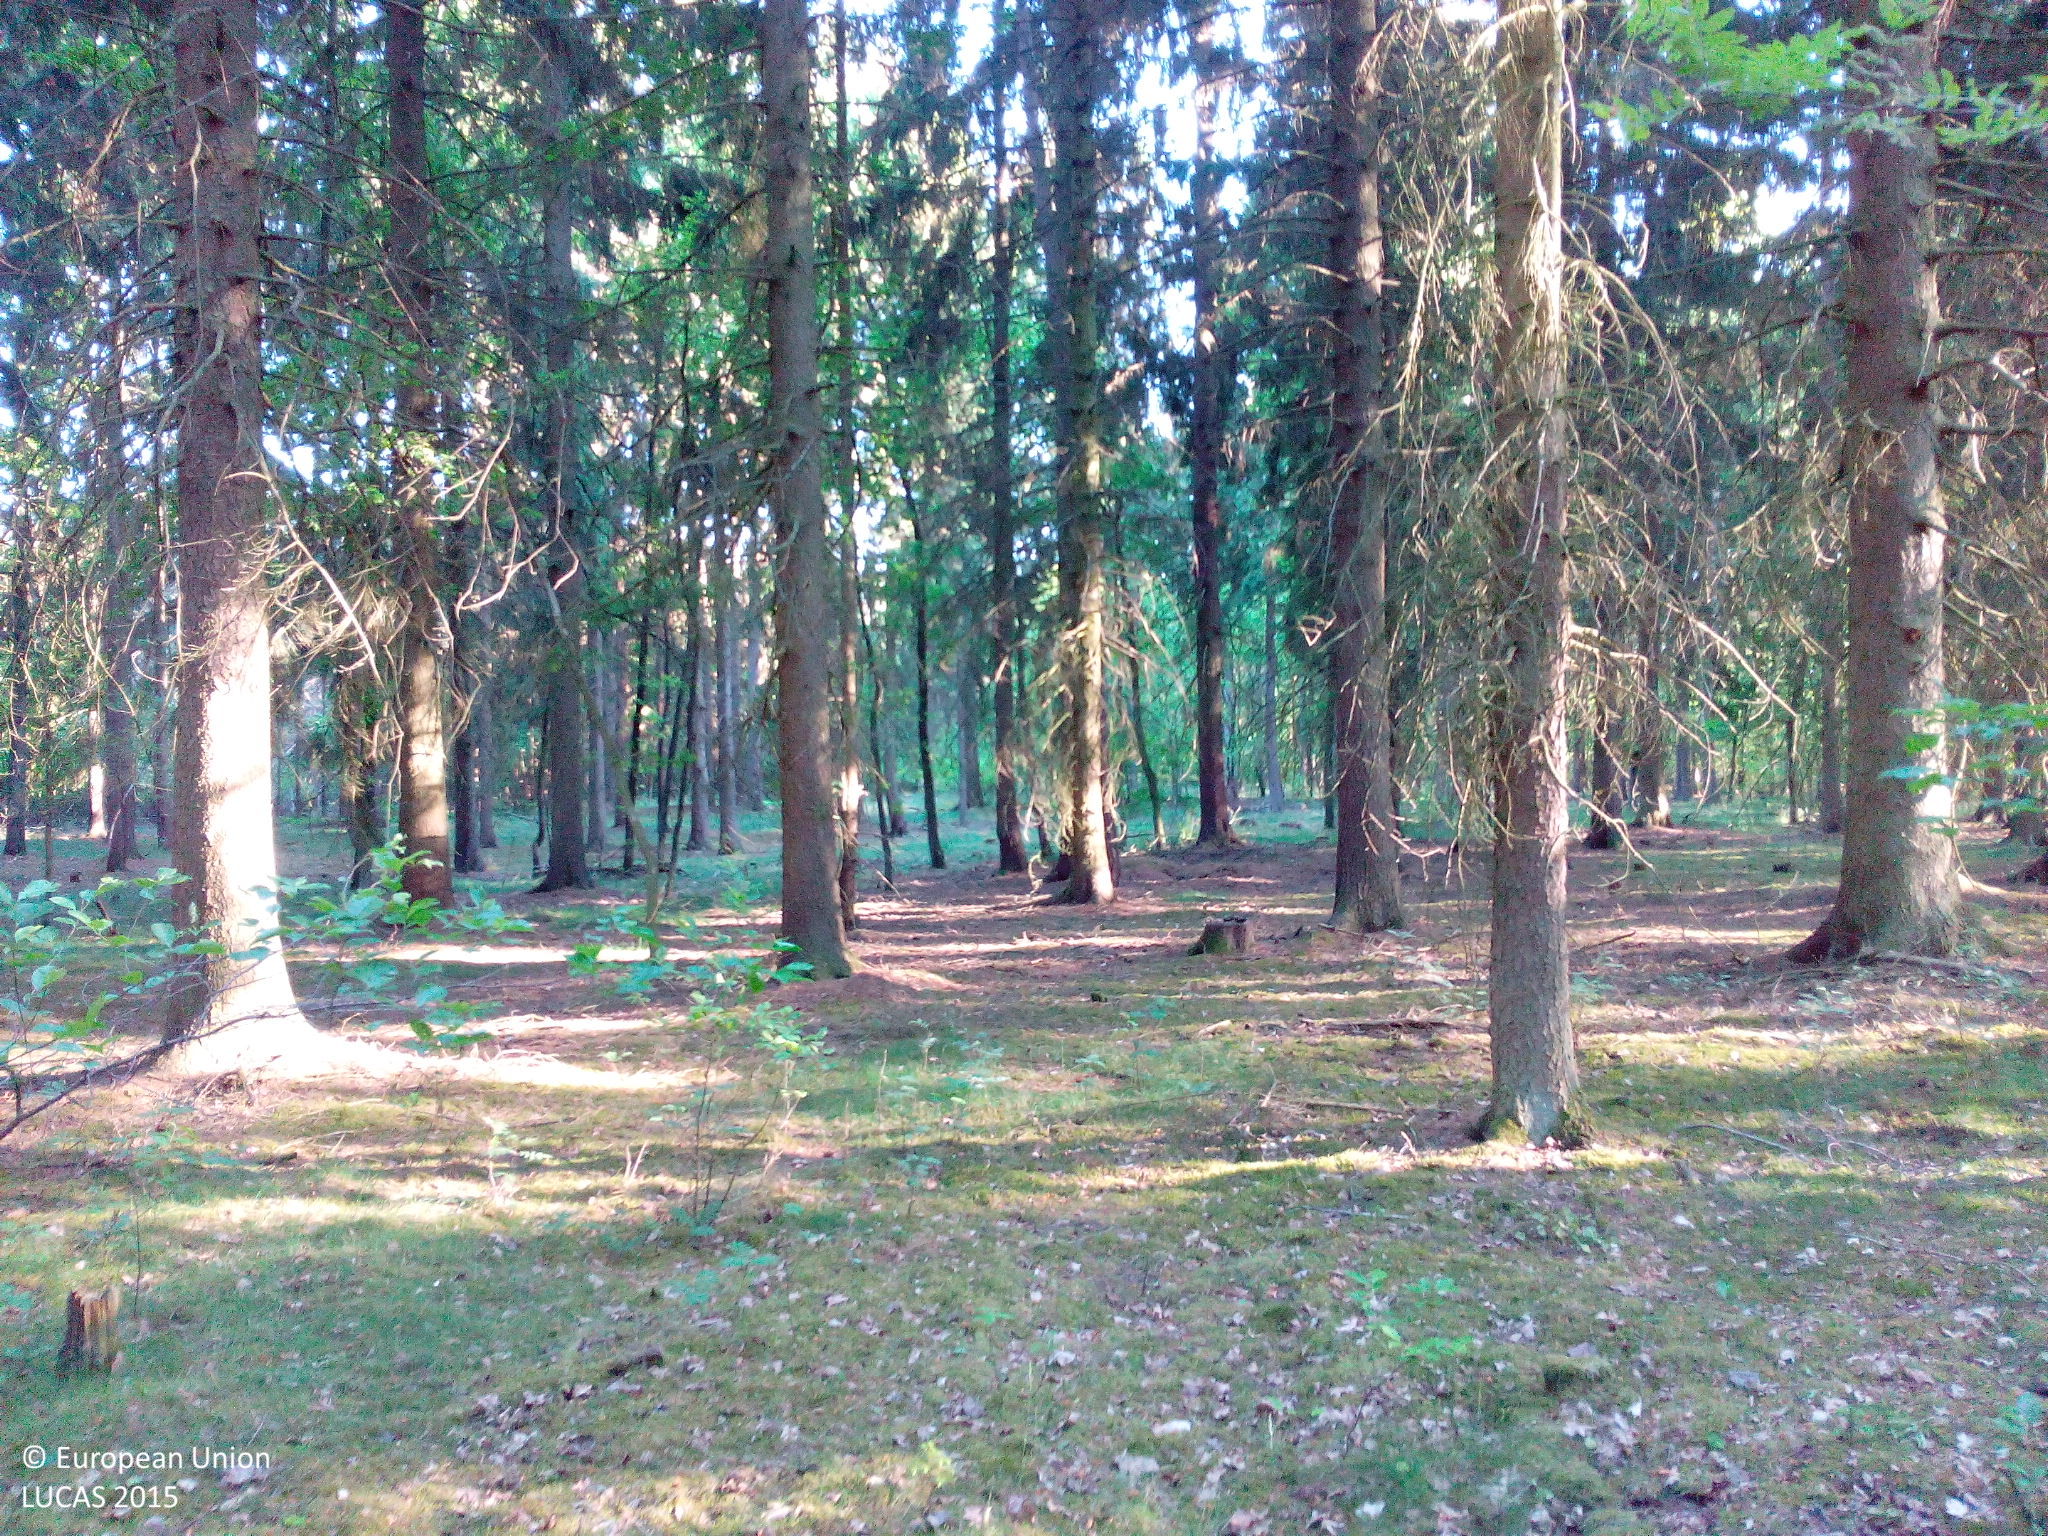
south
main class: Woodland
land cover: Pine dominated coniferous woodland
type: hemiboreal forest and nemoral coniferous forest and mixed broadleaved-coniferous forest
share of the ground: 50 - 75 %
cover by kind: coniferous forest trees 50 %, broadleaved forest trees 15 %, herbaceous plants 15 %, lichens and mosses 10 %, shrubs 5 %, unconsolidated bare surface 5 %
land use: Forestry
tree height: > 5 m
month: June
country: DE
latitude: 53.2353
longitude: 12.3516
